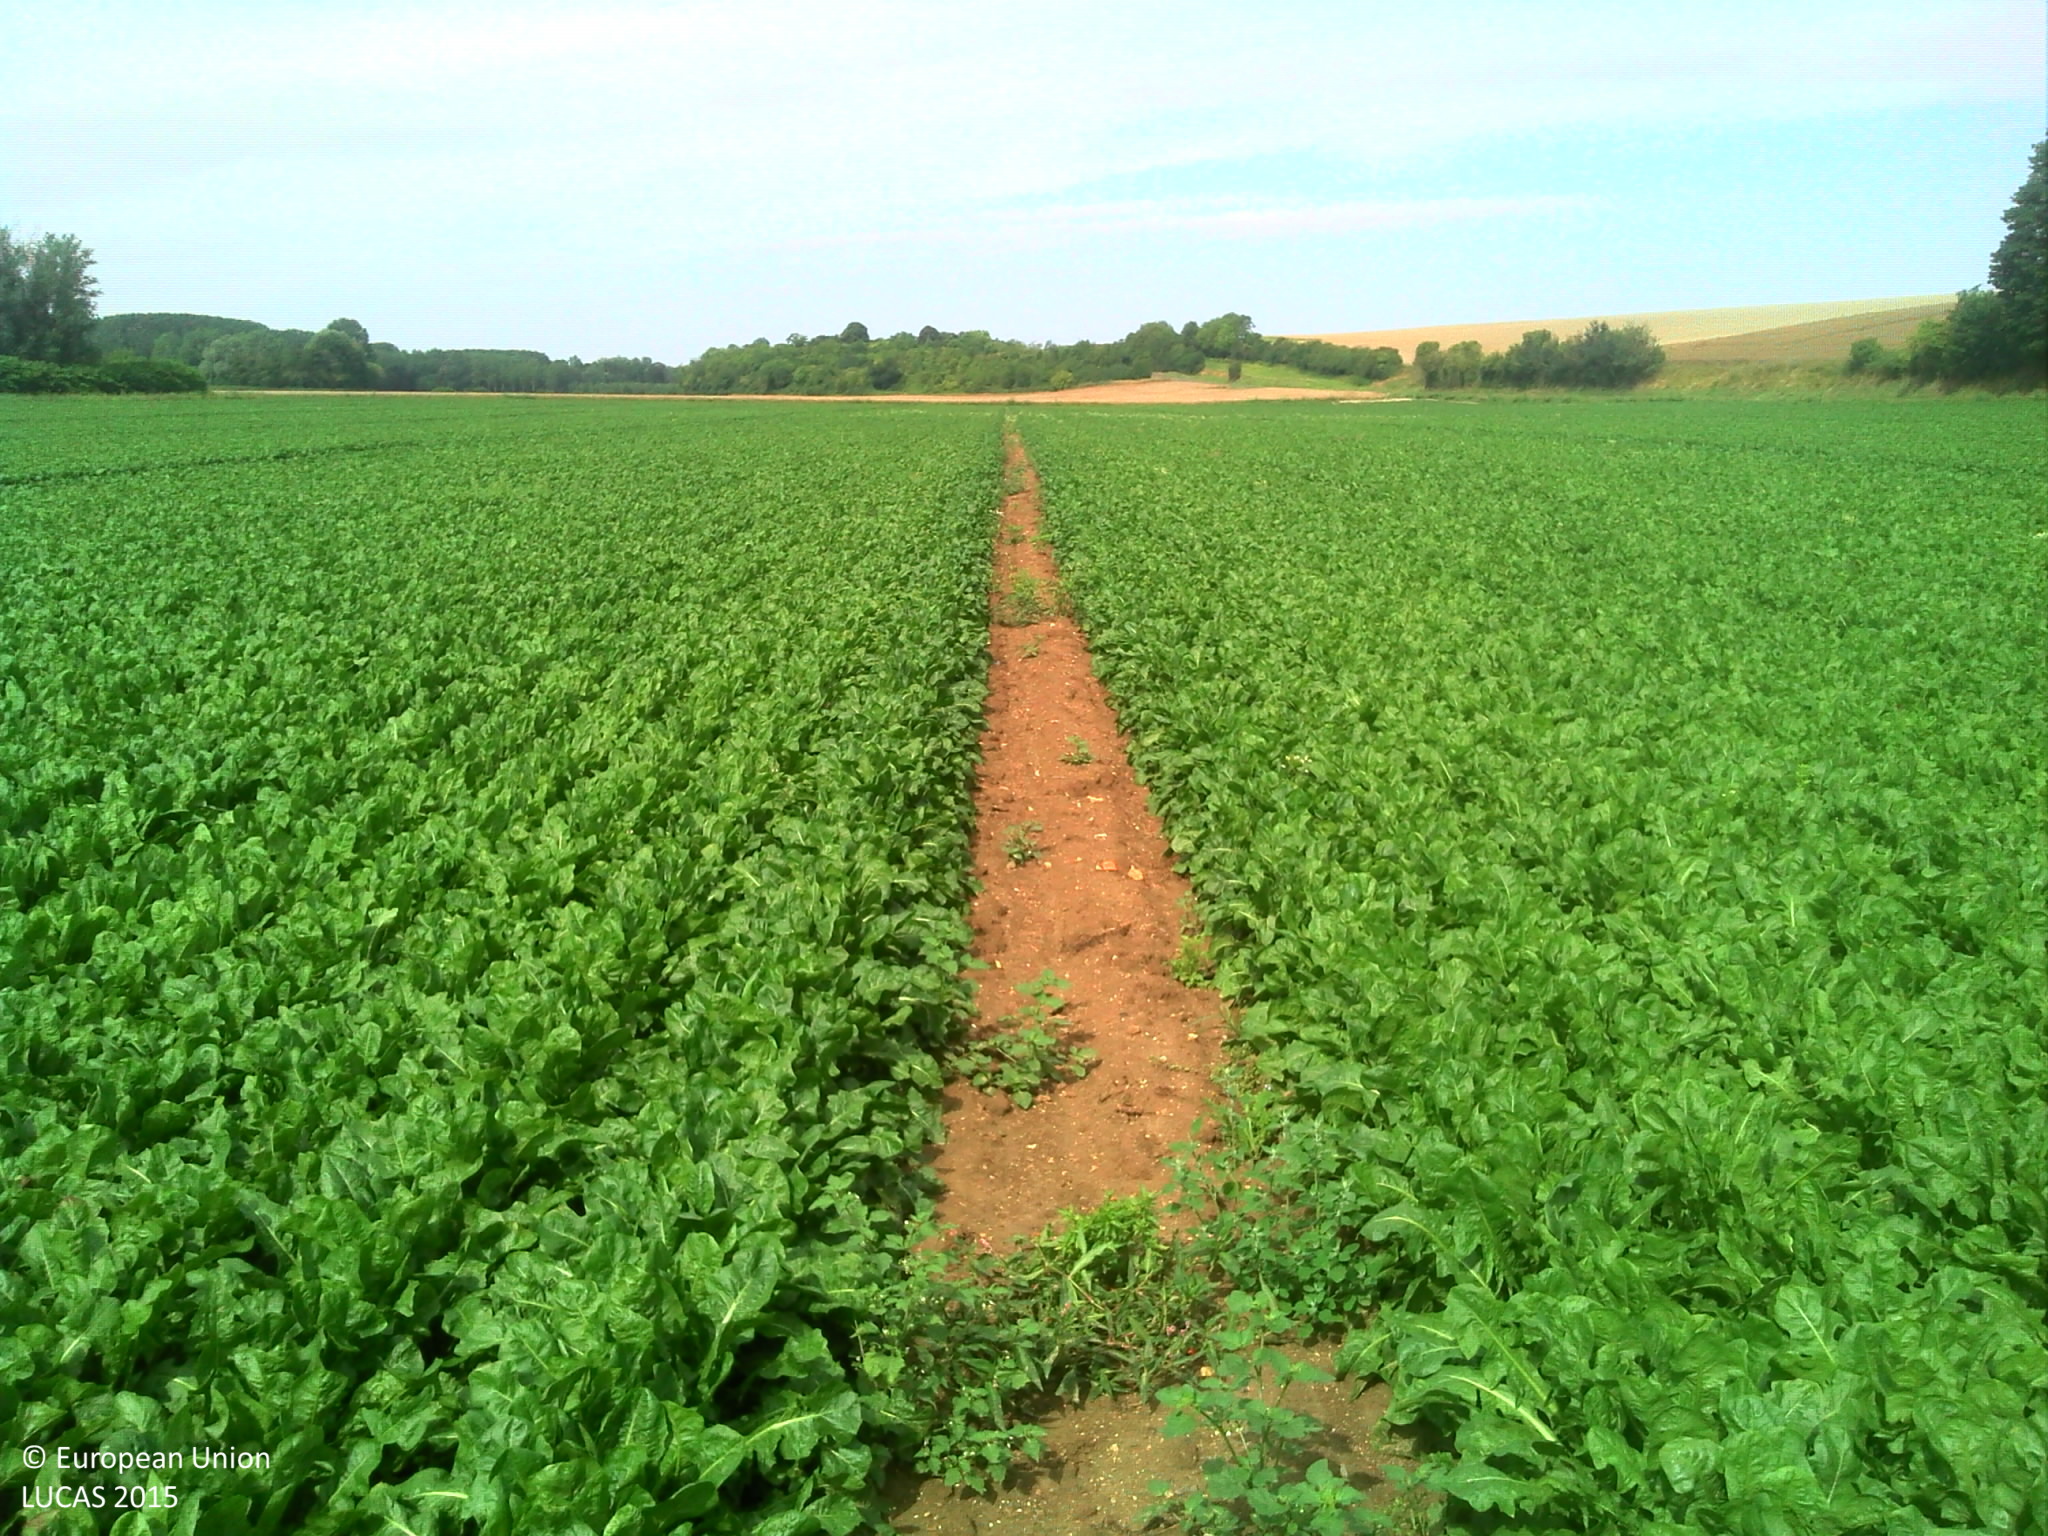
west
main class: Cropland
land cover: Sugar beet
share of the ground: > 75 %
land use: Agriculture (excluding fallow land and kitchen gardens)
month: July
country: FR
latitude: 49.6978
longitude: 3.6017
